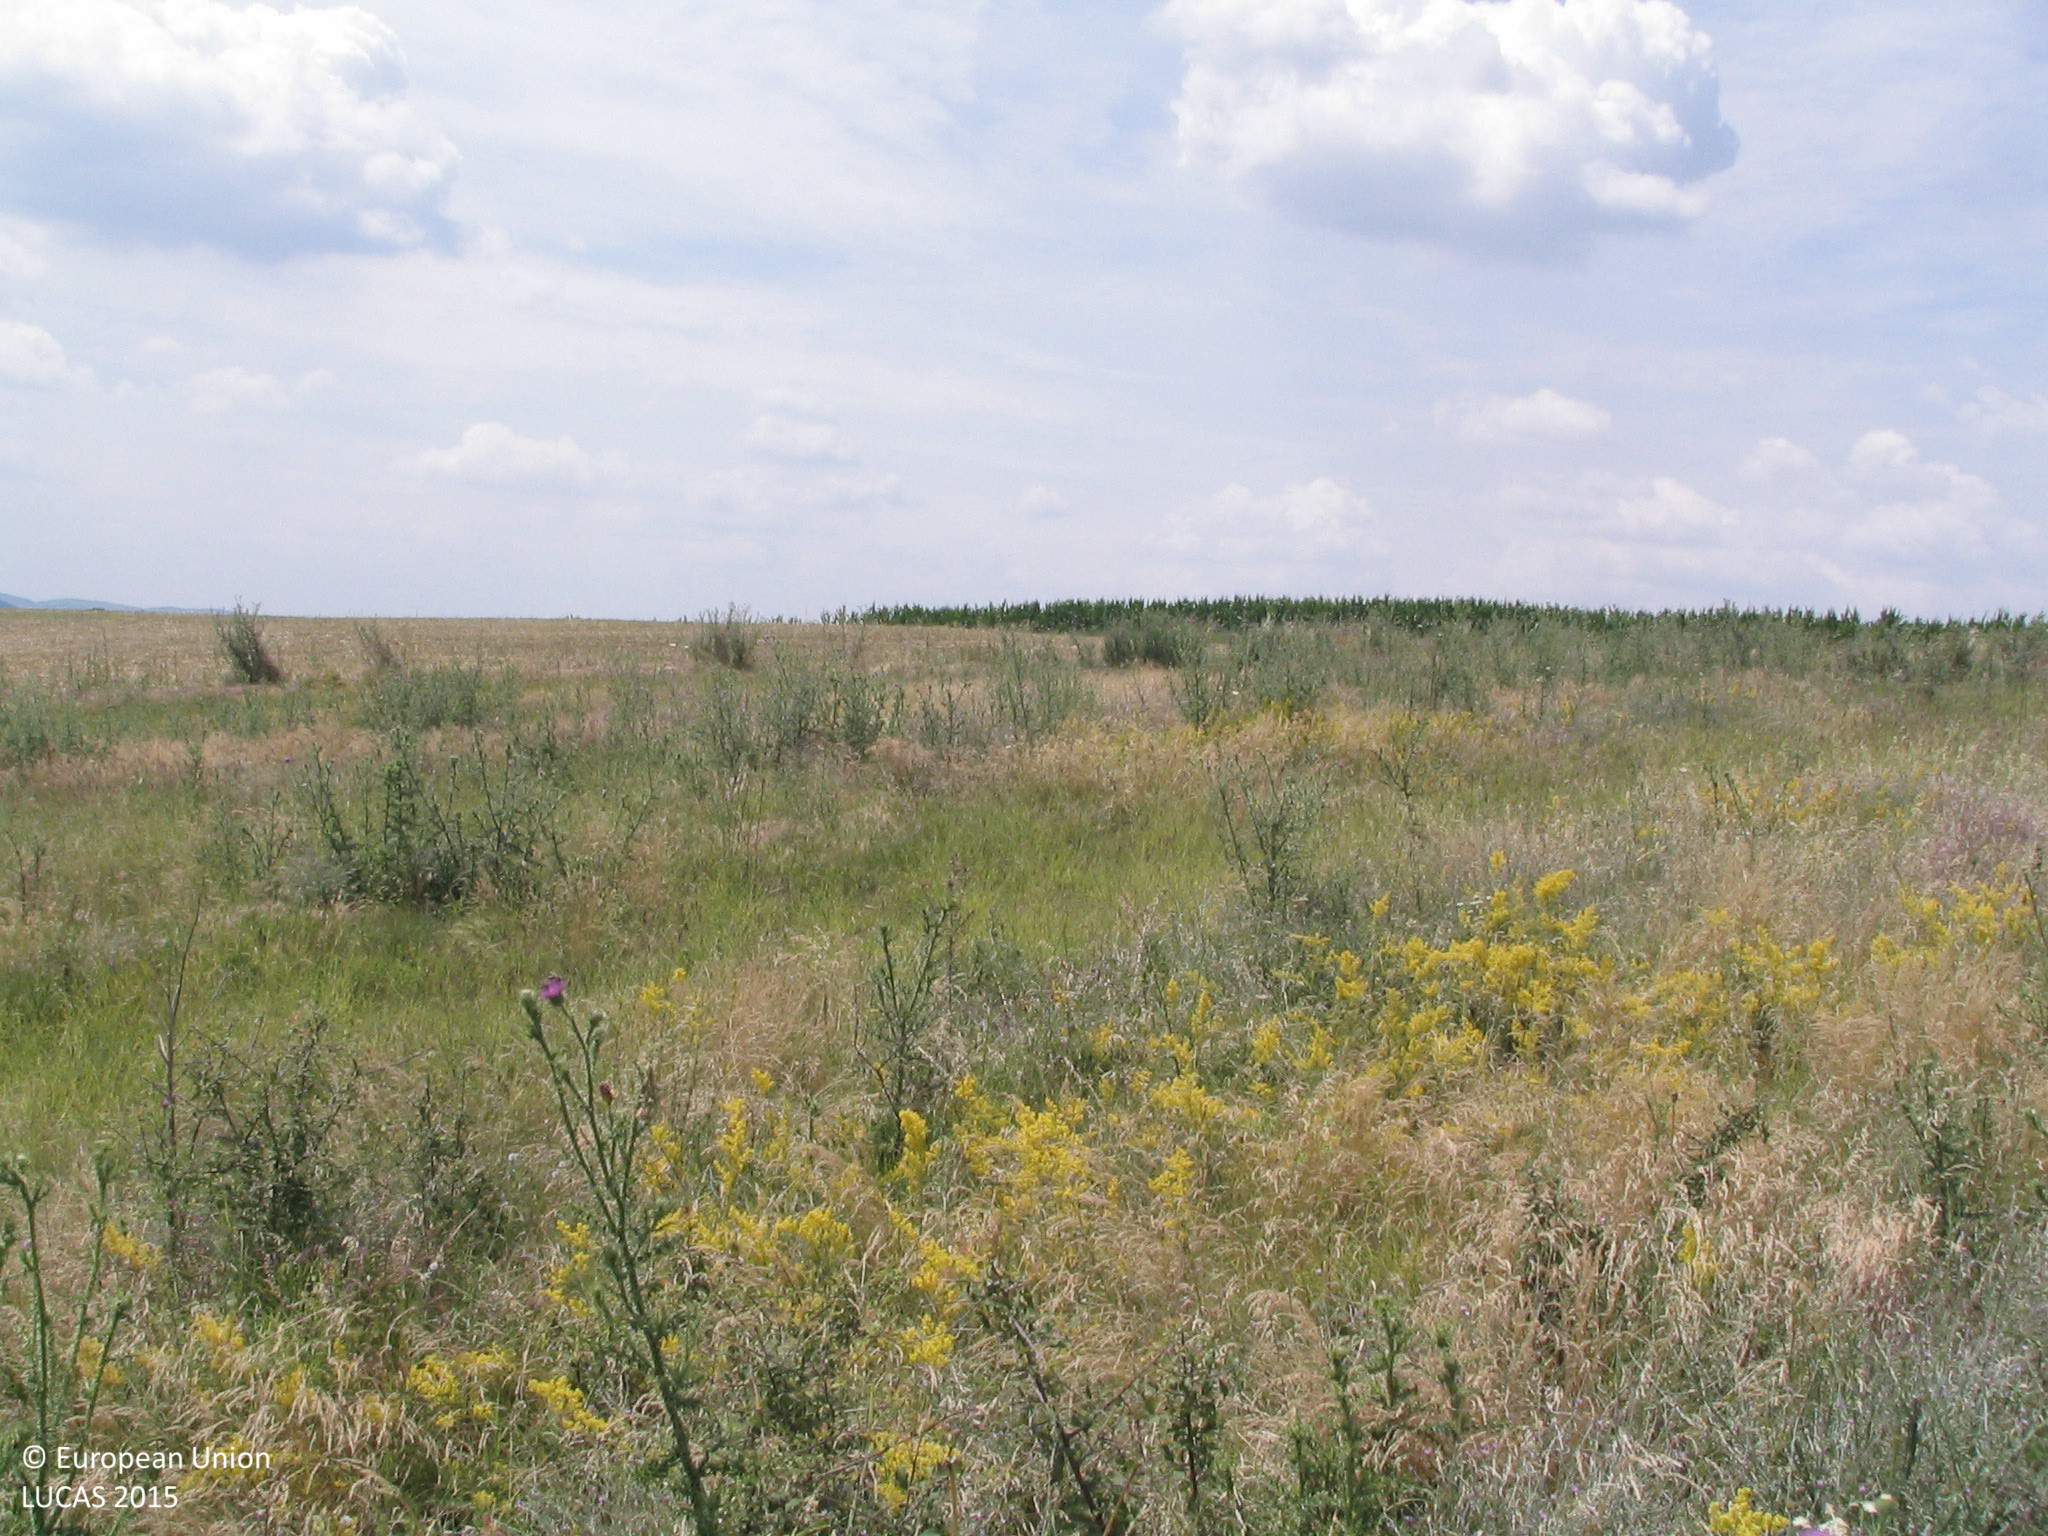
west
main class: Grassland
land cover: Grassland without tree/shrub cover
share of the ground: > 75 %
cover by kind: herbaceous plants 95 %, shrubs 5 %
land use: Semi-natural and natural areas not in use
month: June
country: BG
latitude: 43.3232
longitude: 23.9980
